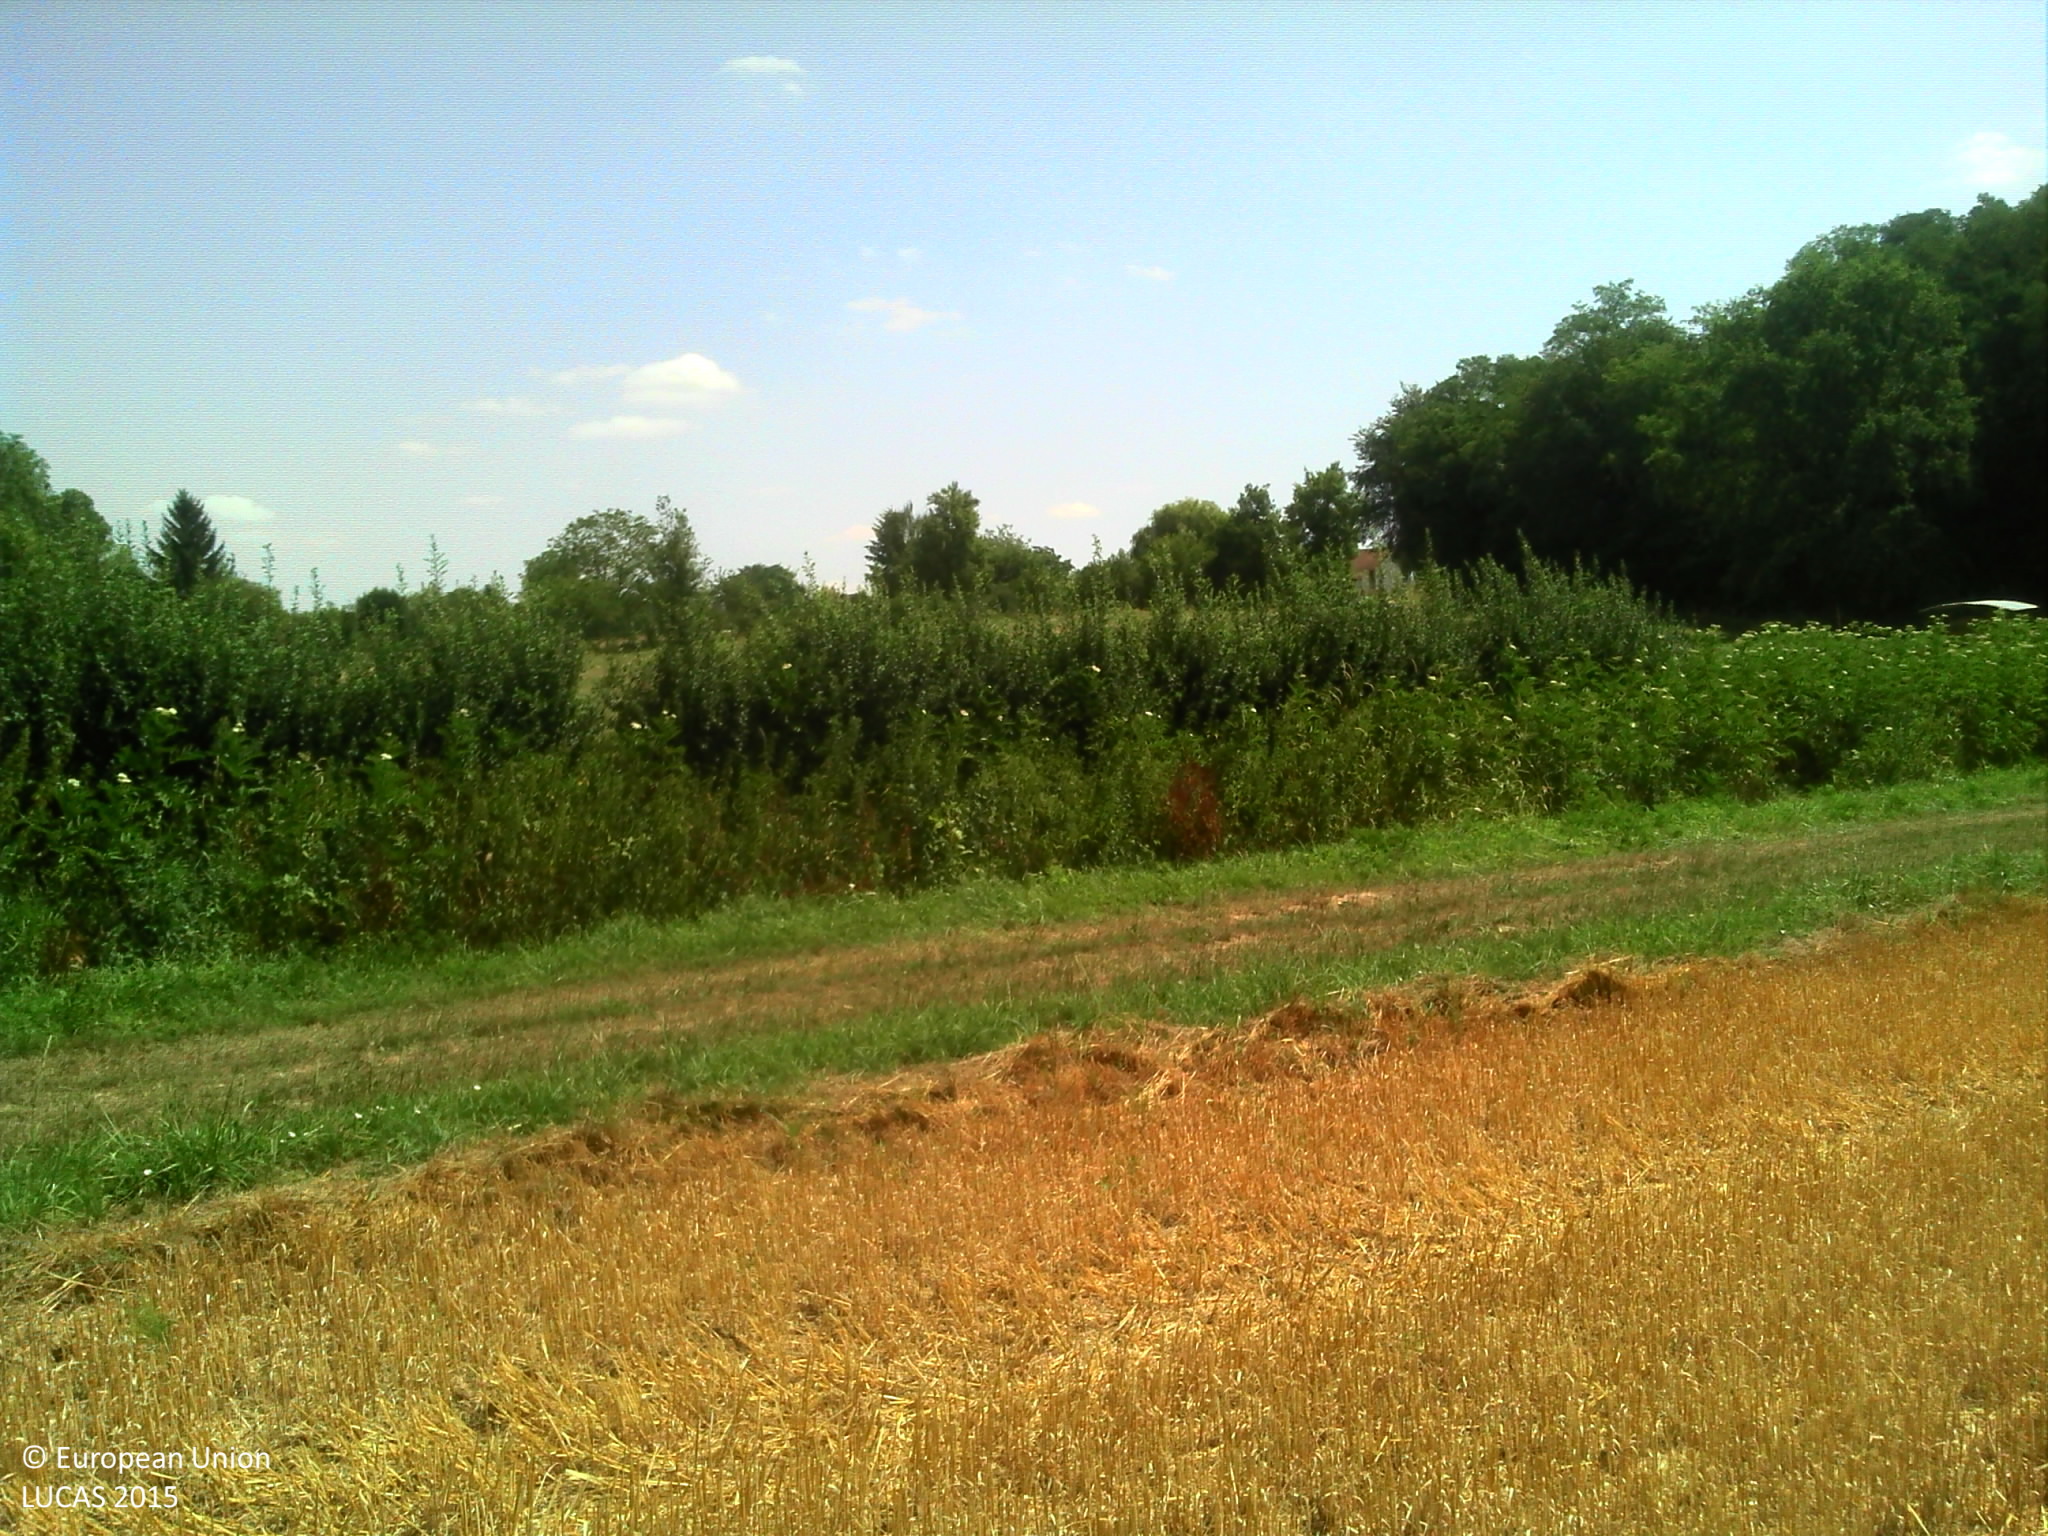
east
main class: Cropland
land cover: Common wheat
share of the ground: > 75 %
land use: Agriculture (excluding fallow land and kitchen gardens)
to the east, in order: Common wheat; Tracks; Grass margins; Managed hedges; Grassland without tree/shrub cover; Fences; Grassland without tree/shrub cover; Artificial constructions in urban areas
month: July
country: FR
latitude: 46.9246
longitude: 5.1029
